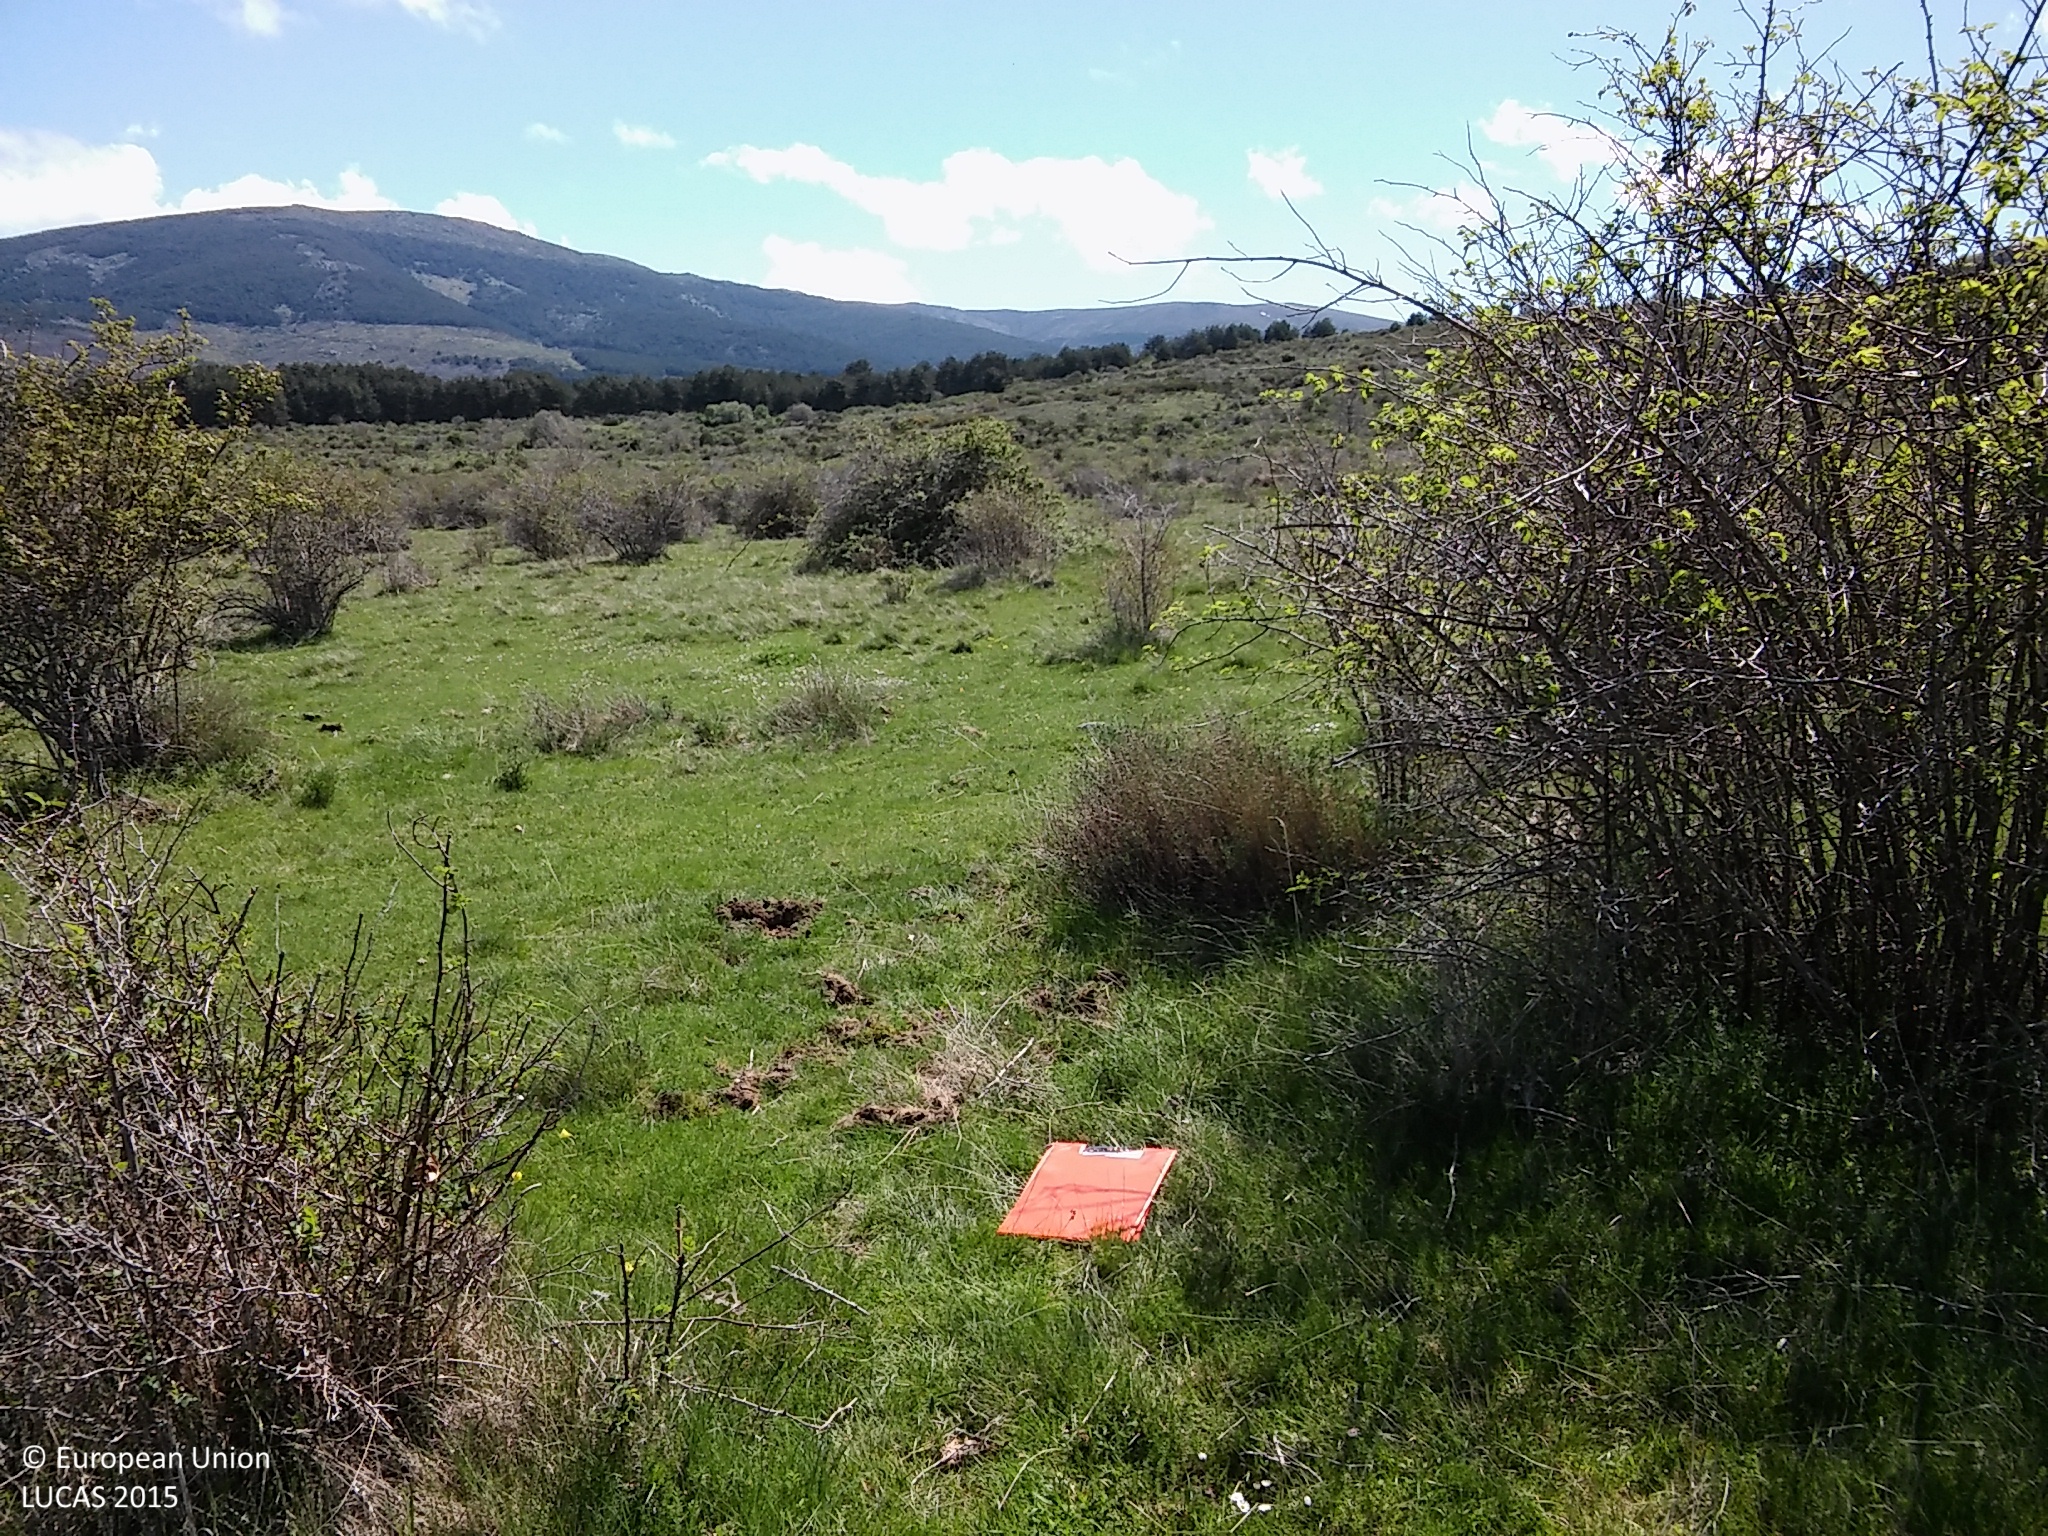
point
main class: Shrubland
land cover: Shrubland without tree cover
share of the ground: 10 - 25 %
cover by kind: herbaceous plants 60 %, shrubs 40 %
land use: Agriculture (excluding fallow land and kitchen gardens)
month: May
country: ES
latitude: 40.9853
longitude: -3.9668
